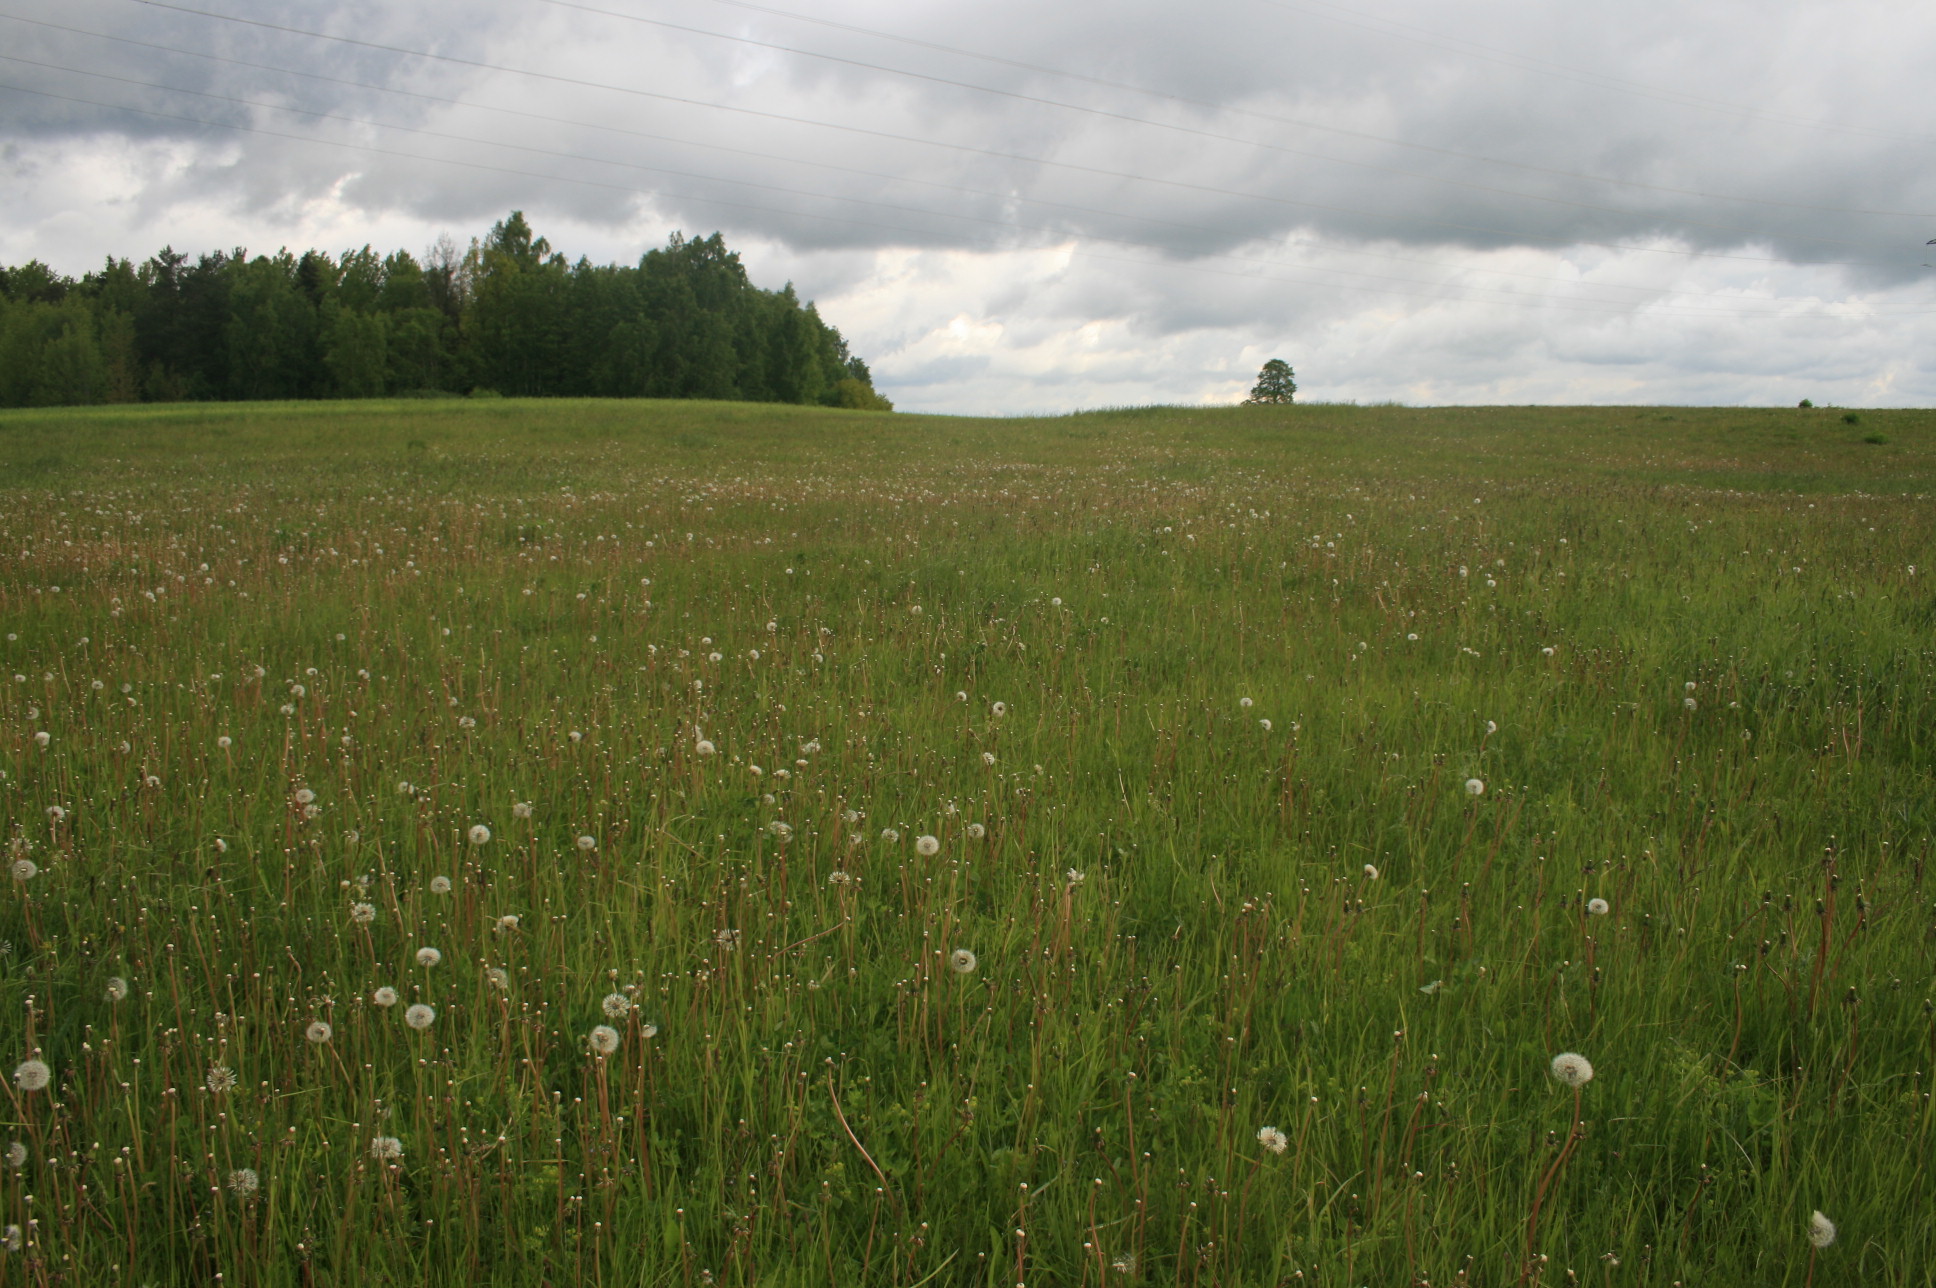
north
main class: Grassland
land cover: Grassland without tree/shrub cover
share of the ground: > 75 %
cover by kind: herbaceous plants 100 %
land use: Agriculture (excluding fallow land and kitchen gardens)
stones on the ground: < 10 %
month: May
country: LT
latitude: 55.9338
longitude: 21.9767
